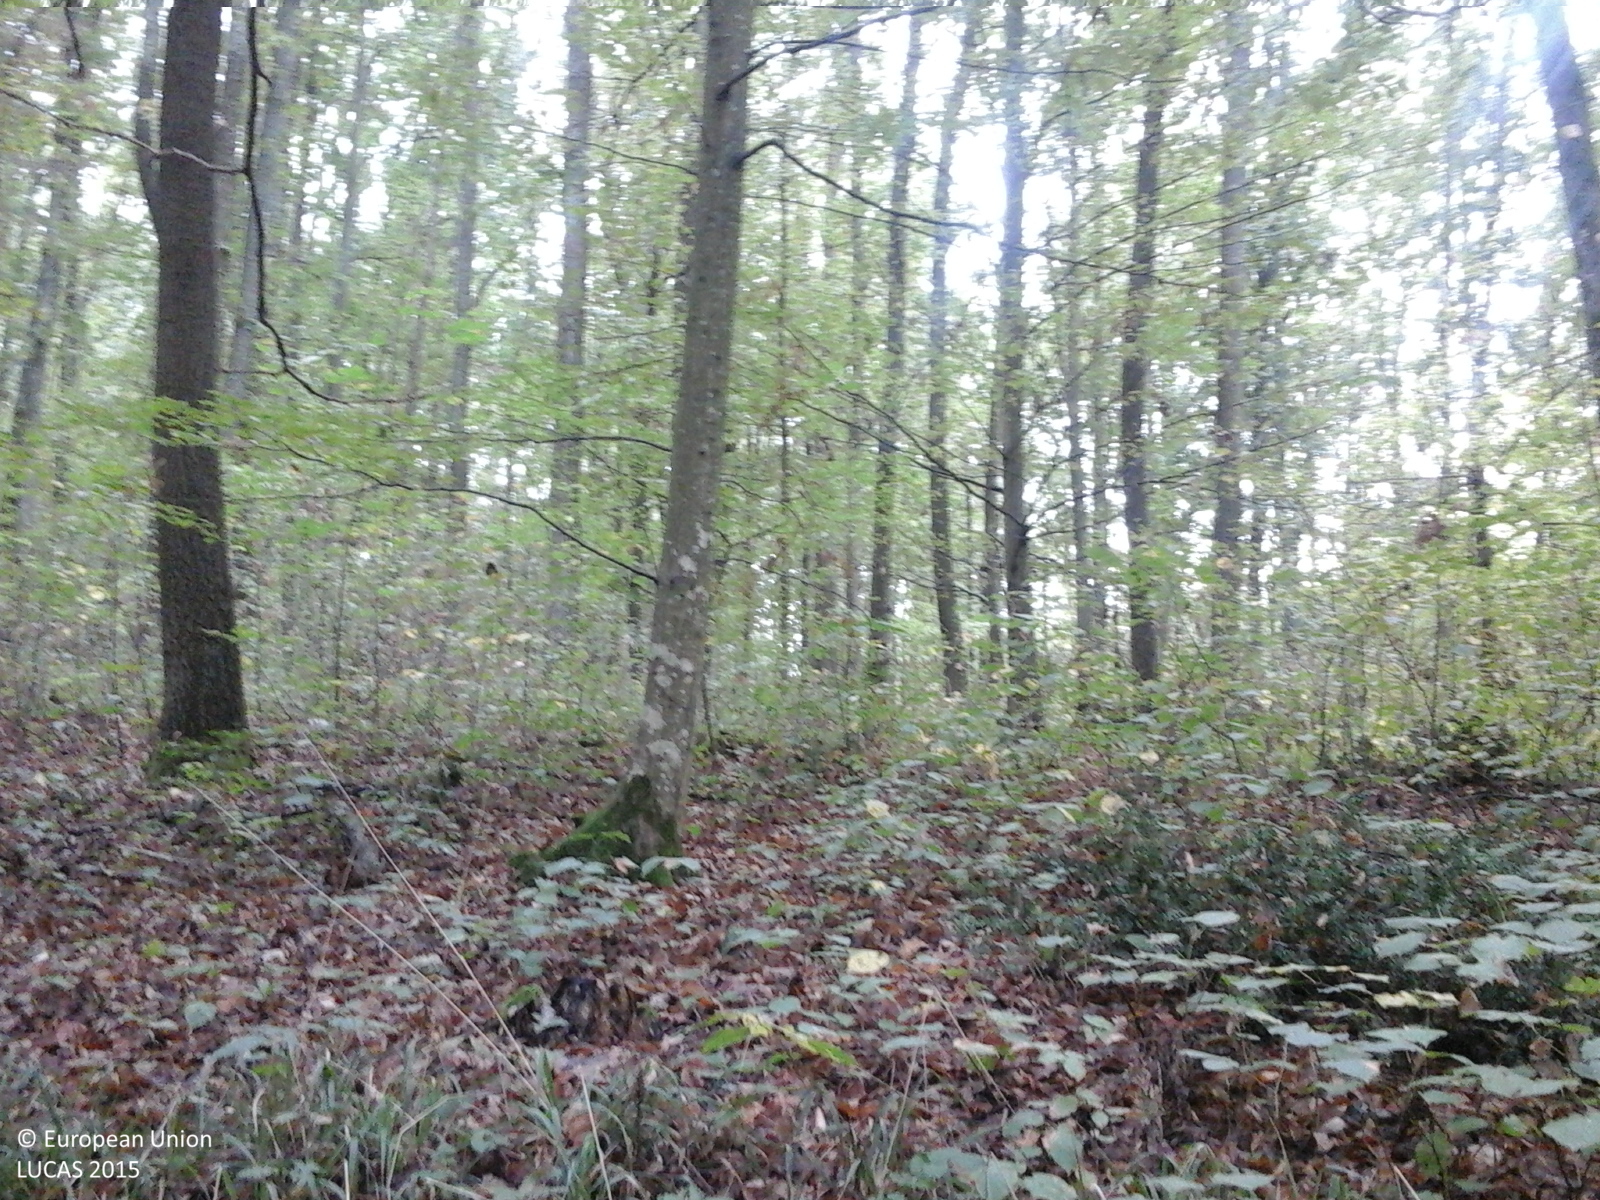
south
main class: Woodland
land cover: Broadleaved woodland
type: mesophytic deciduous forest
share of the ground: > 75 %
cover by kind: broadleaved forest trees 100 %
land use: Forestry
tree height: > 5 m
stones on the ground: 10 - 25 %
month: September
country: RO
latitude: 45.9049
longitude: 22.1993
